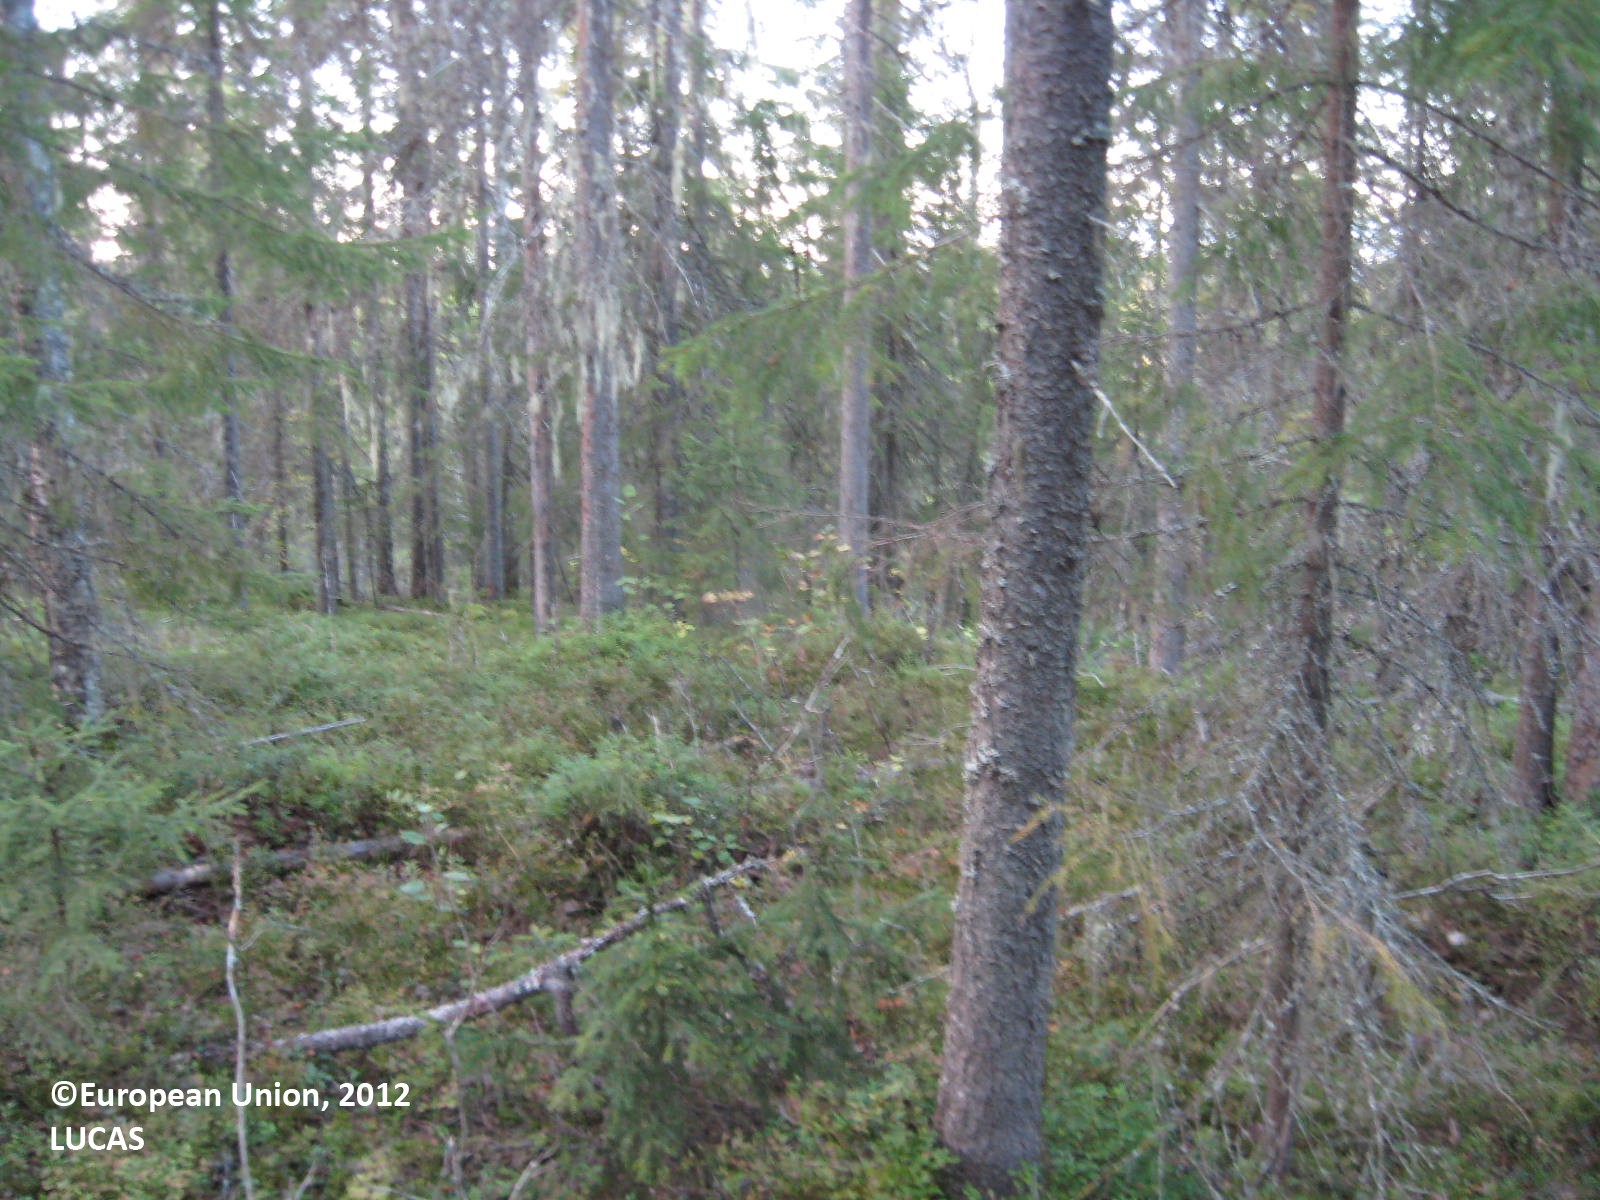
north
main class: Woodland
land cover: Other coniferous woodland
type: boreal forest
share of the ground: > 75 %
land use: Forestry
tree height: > 5 m
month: August
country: FI
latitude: 63.8789
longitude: 29.7982
